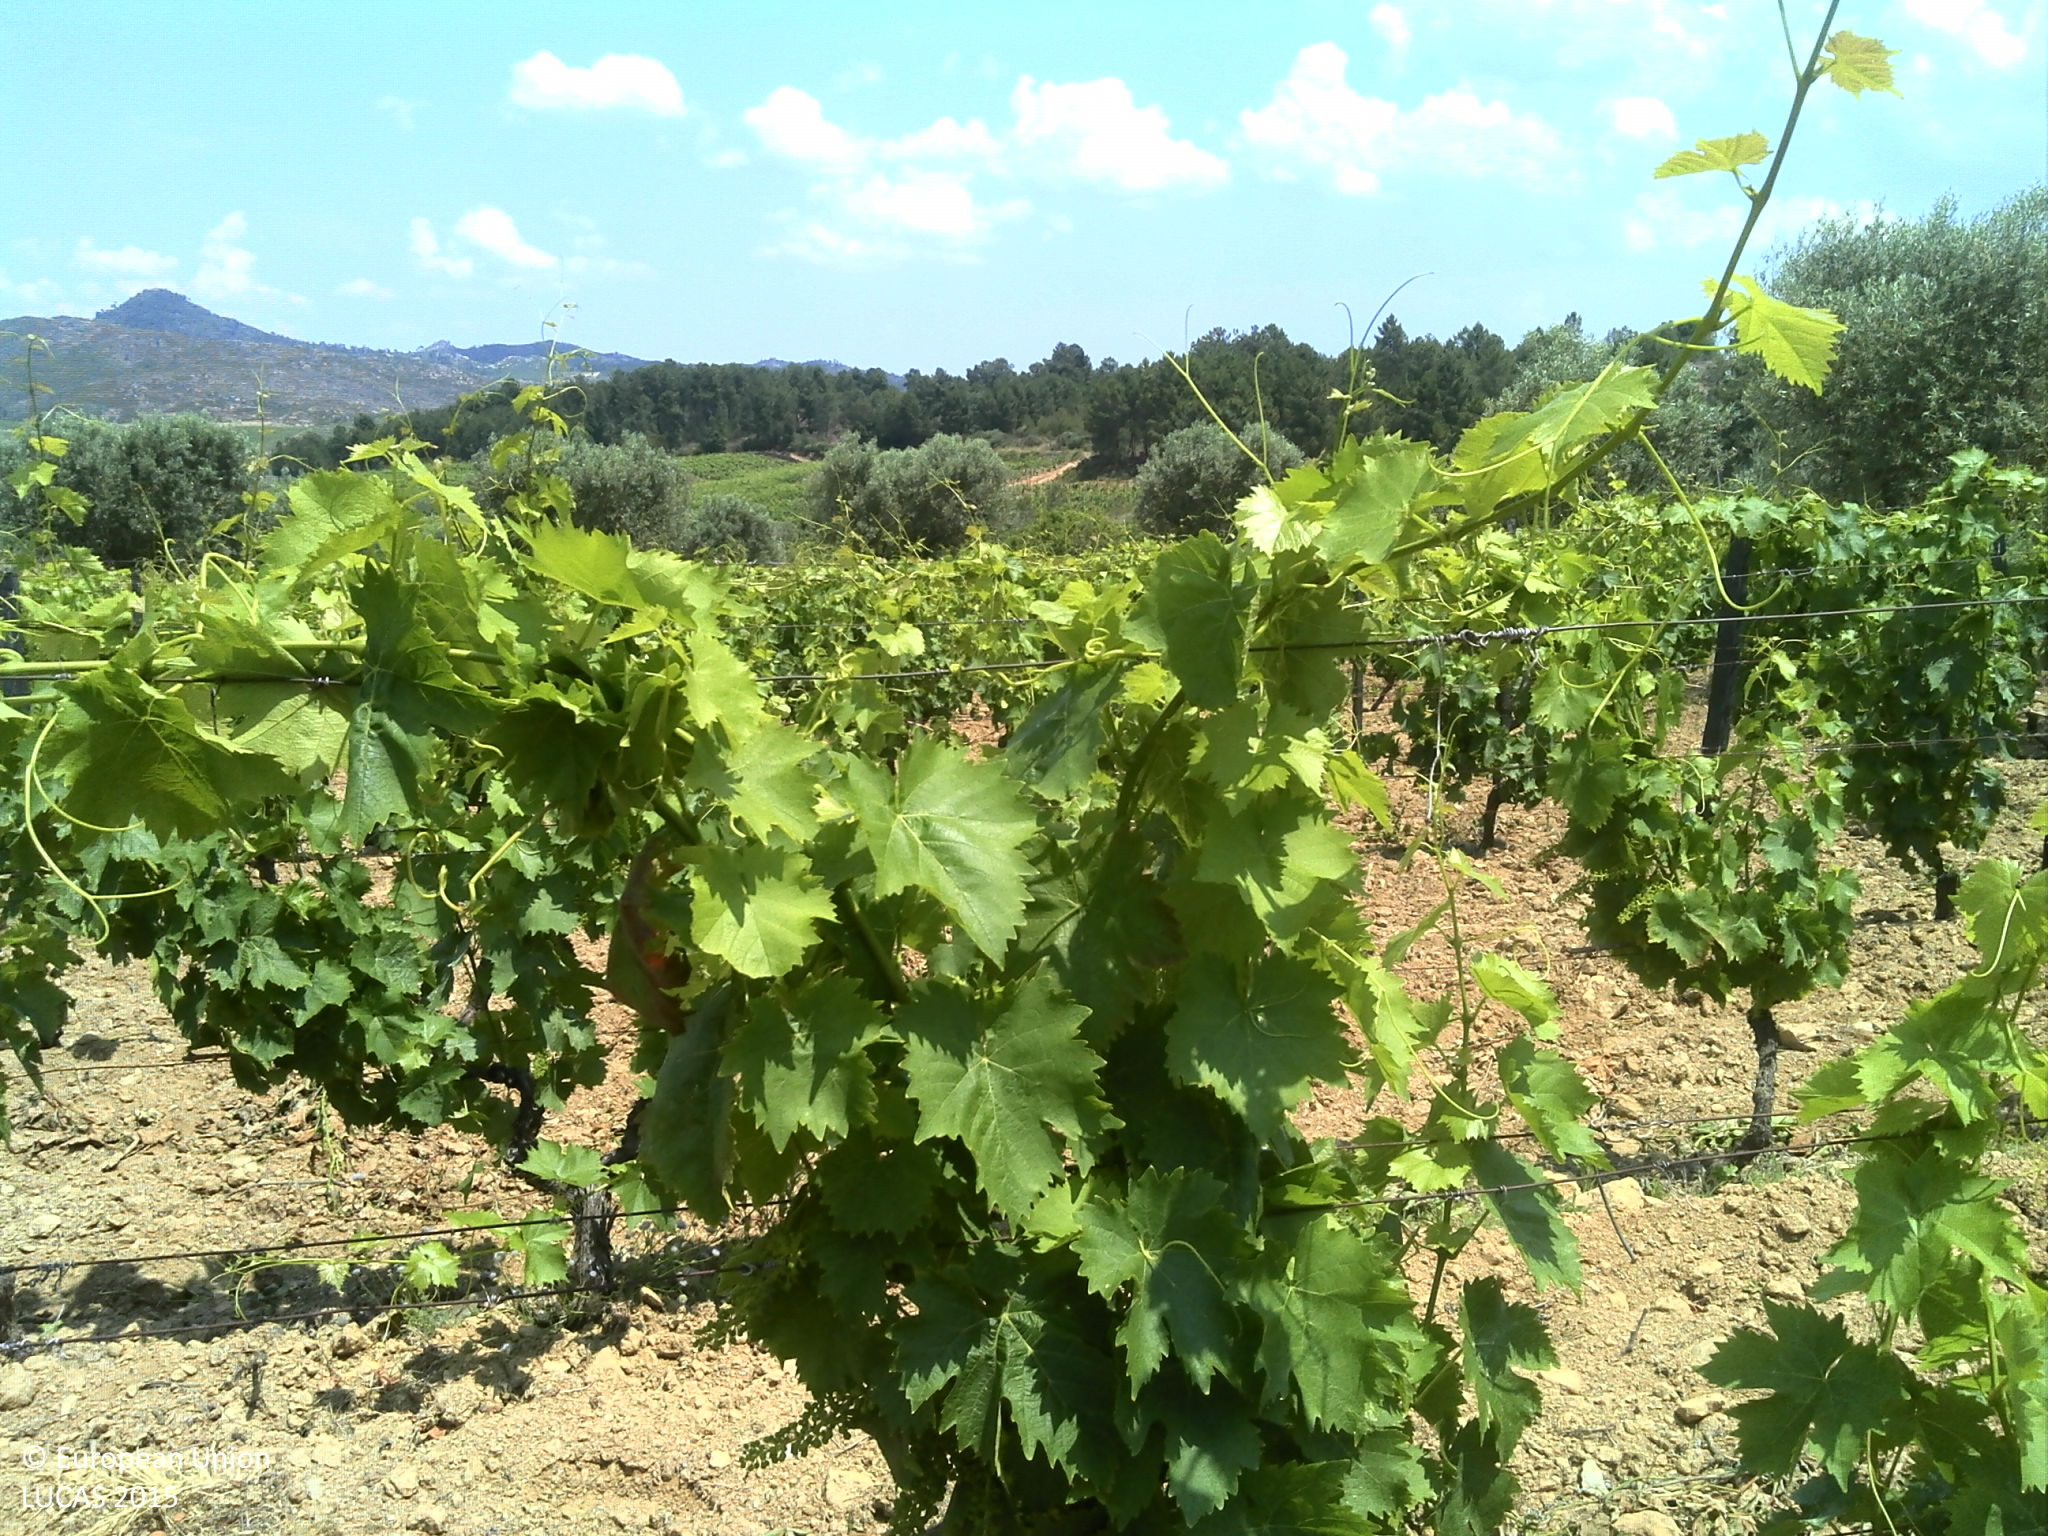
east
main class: Cropland
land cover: Vineyards
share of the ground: 10 - 25 %
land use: Agriculture (excluding fallow land and kitchen gardens)
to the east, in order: Vineyards; Olive groves; Dry stone walls; Tracks; Artificial constructions; Vineyards; Apple fruit; Dry stone walls; Rivers and streams; Dry stone walls; Vineyards; Shrubland with sparse tree cover; Vineyards
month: June
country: PT
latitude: 41.2697
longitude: -7.4676
